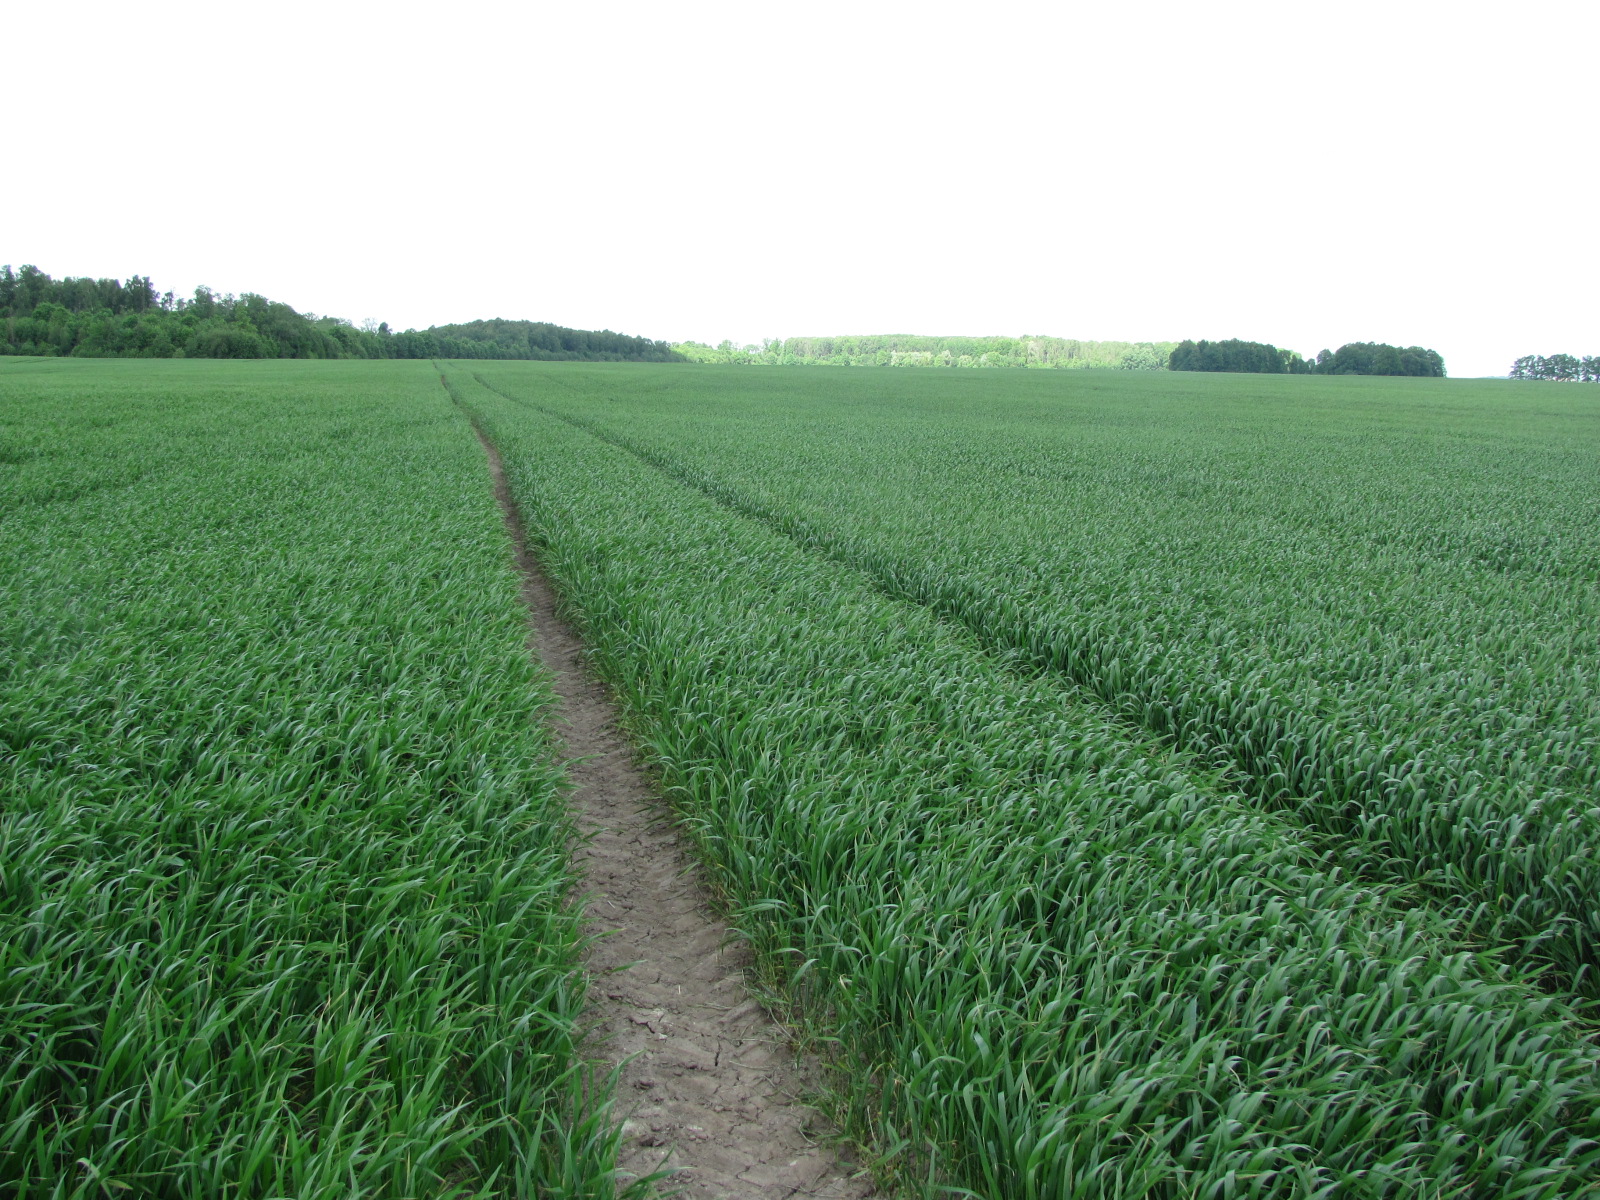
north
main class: Cropland
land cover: Common wheat
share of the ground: > 75 %
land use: Agriculture (excluding fallow land and kitchen gardens)
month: June
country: LV
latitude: 56.2542
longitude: 24.1811
